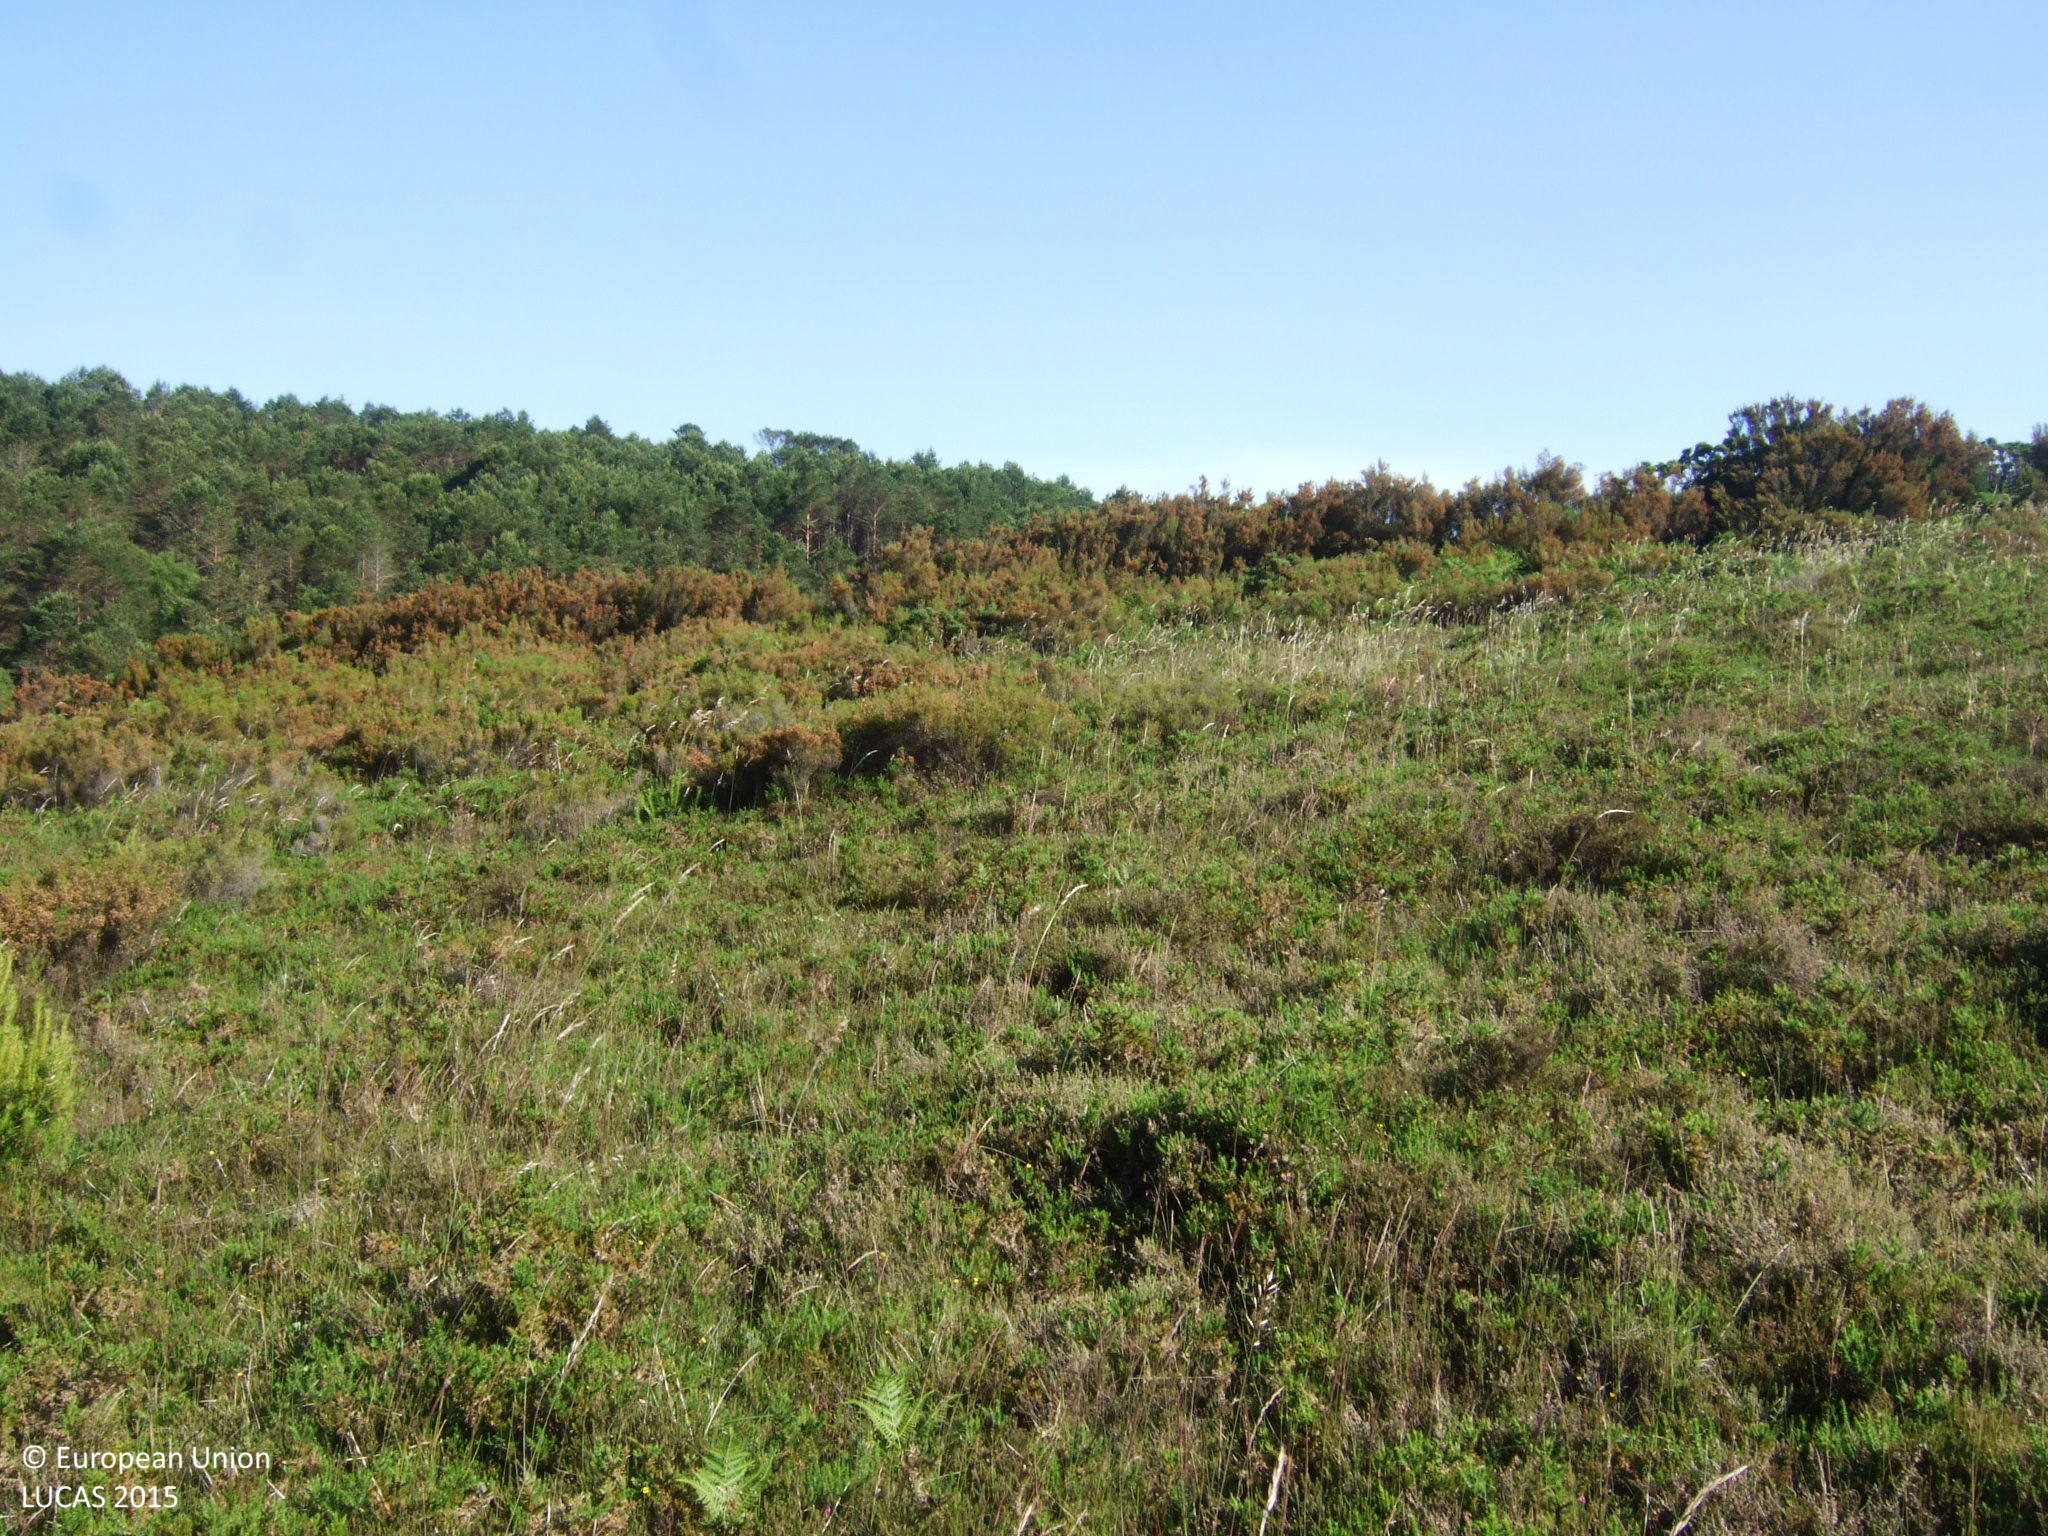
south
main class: Shrubland
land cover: Shrubland without tree cover
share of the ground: > 75 %
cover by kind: shrubs 100 %
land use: Semi-natural and natural areas not in use
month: June
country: ES
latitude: 43.4510
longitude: -7.7469
